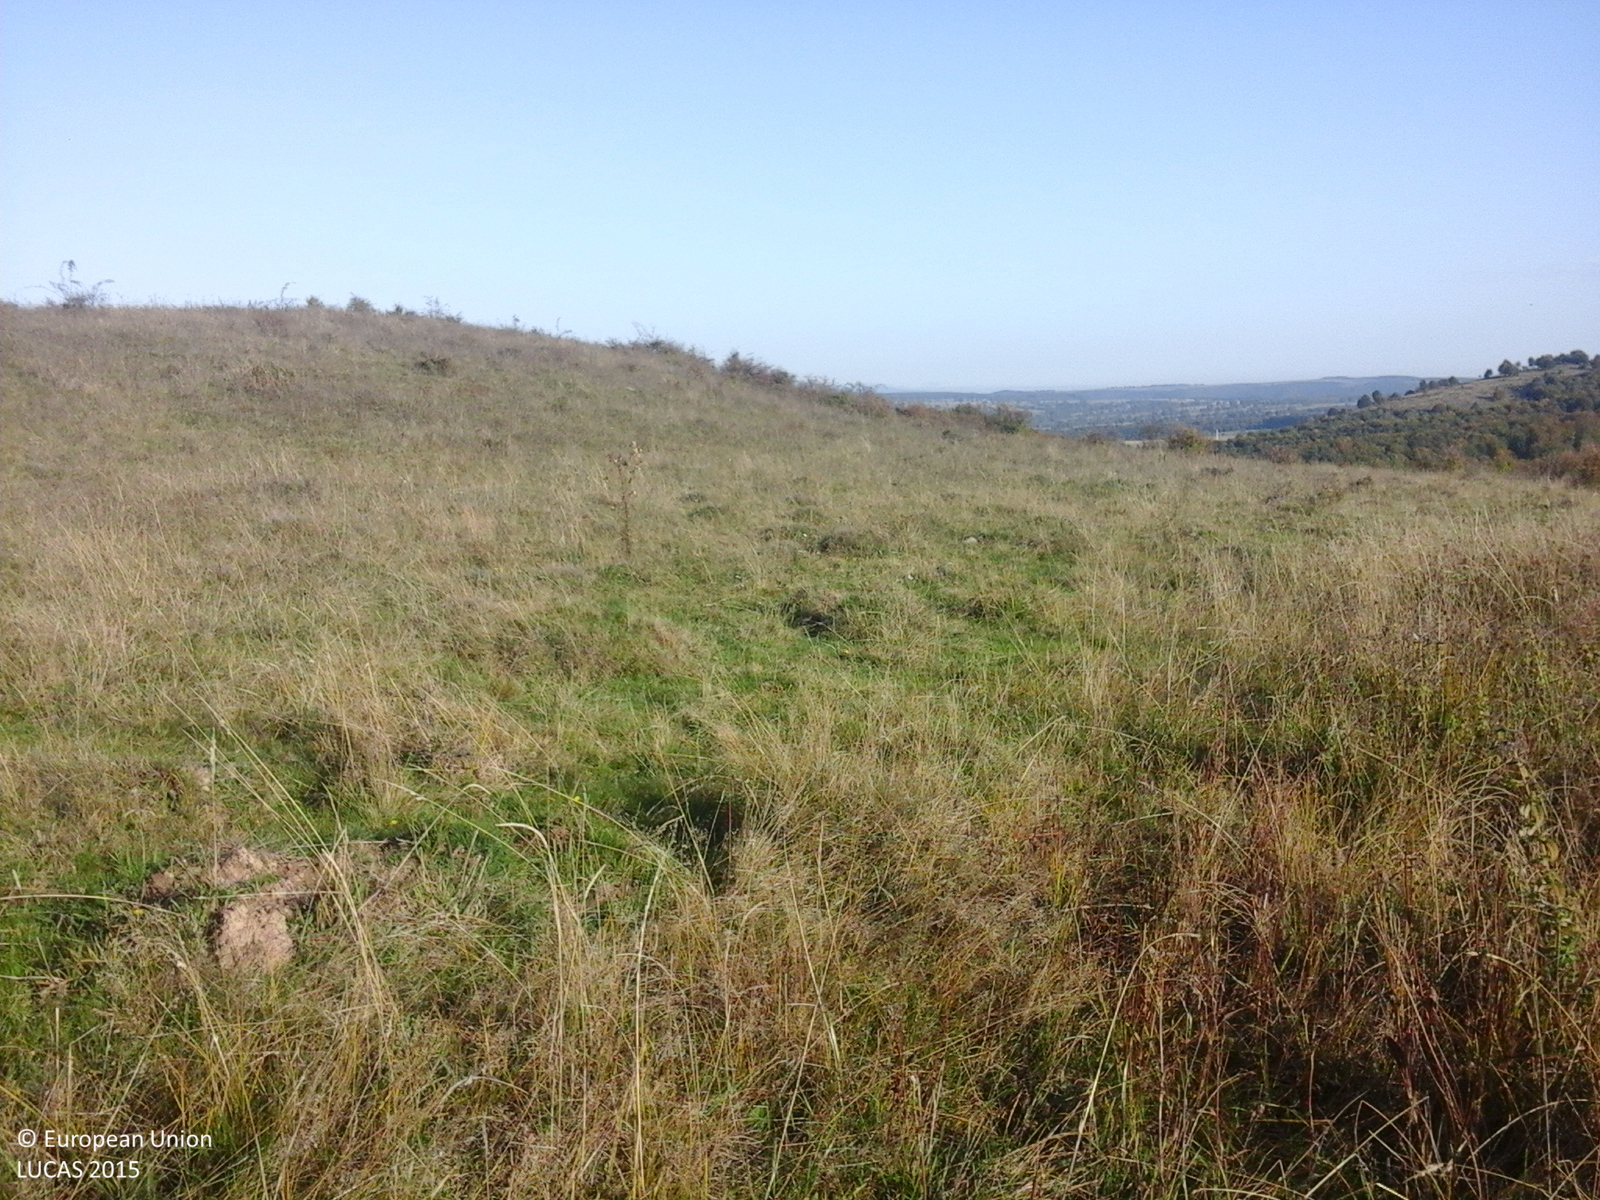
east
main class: Grassland
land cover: Grassland without tree/shrub cover
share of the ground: > 75 %
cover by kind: herbaceous plants 100 %
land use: Agriculture (excluding fallow land and kitchen gardens)
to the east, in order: Grassland without tree/shrub cover; Tracks; Grassland without tree/shrub cover; Tracks; Grassland with sparse tree/shrub cover; Grassland without tree/shrub cover
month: October
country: RO
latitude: 46.4526
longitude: 25.1637
